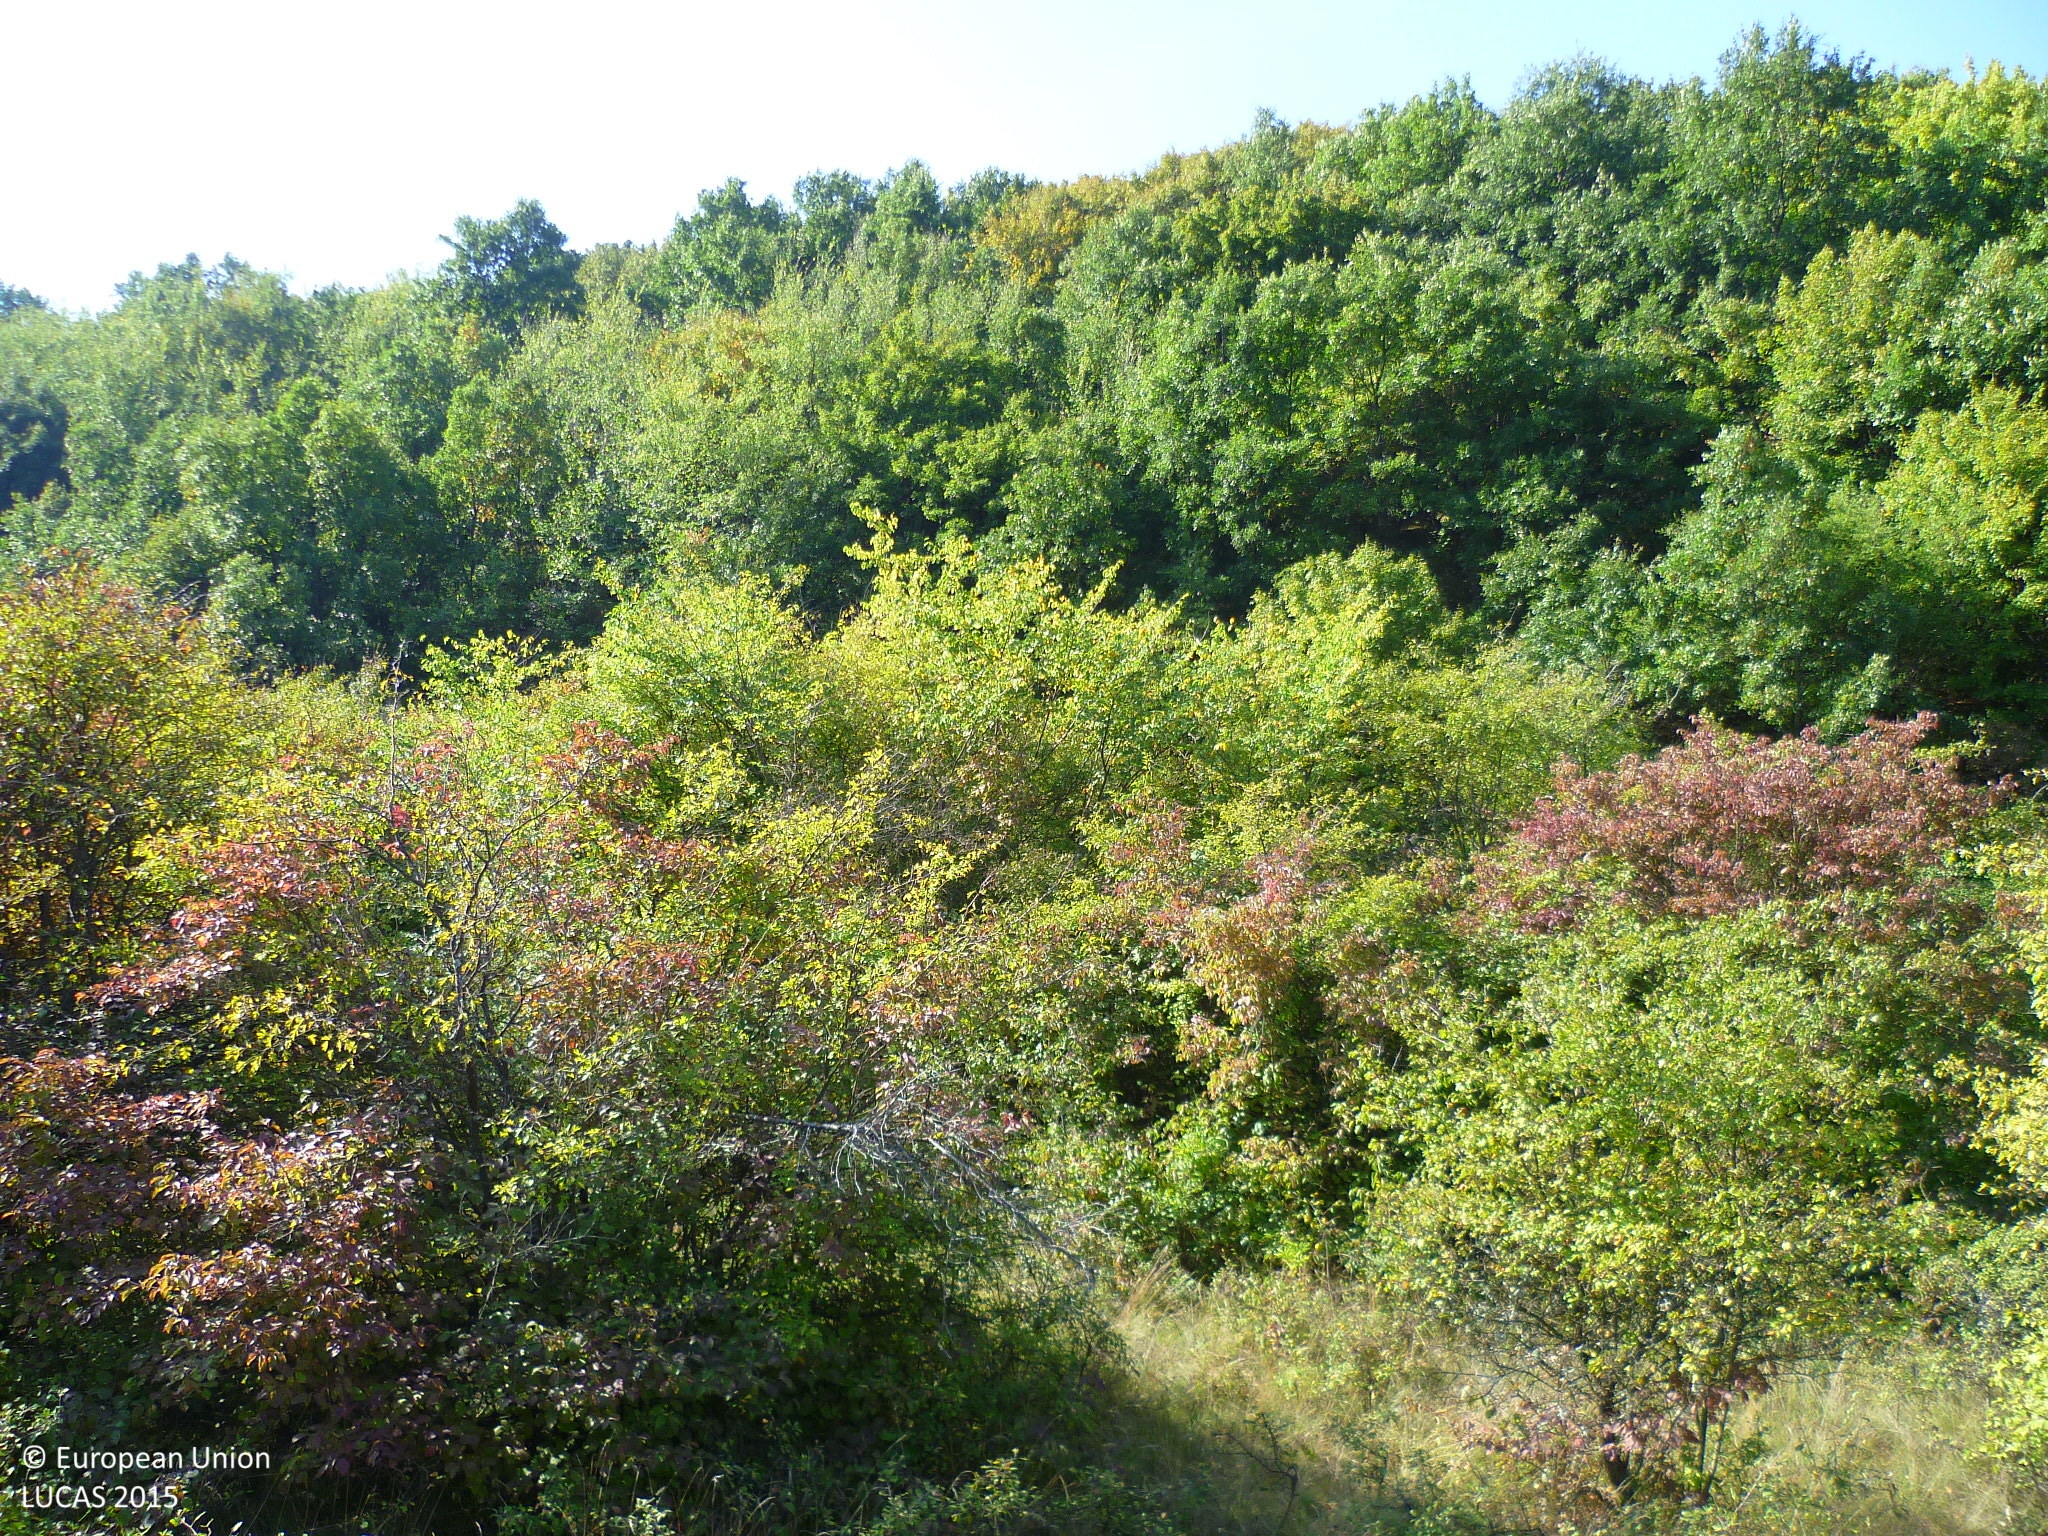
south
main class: Shrubland
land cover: Shrubland with sparse tree cover
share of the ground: 50 - 75 %
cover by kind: shrubs 55 %, herbaceous plants 40 %, broadleaved forest trees 5 %
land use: Semi-natural and natural areas not in use
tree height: < 5 m
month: September
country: BG
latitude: 42.8816
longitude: 22.9226
